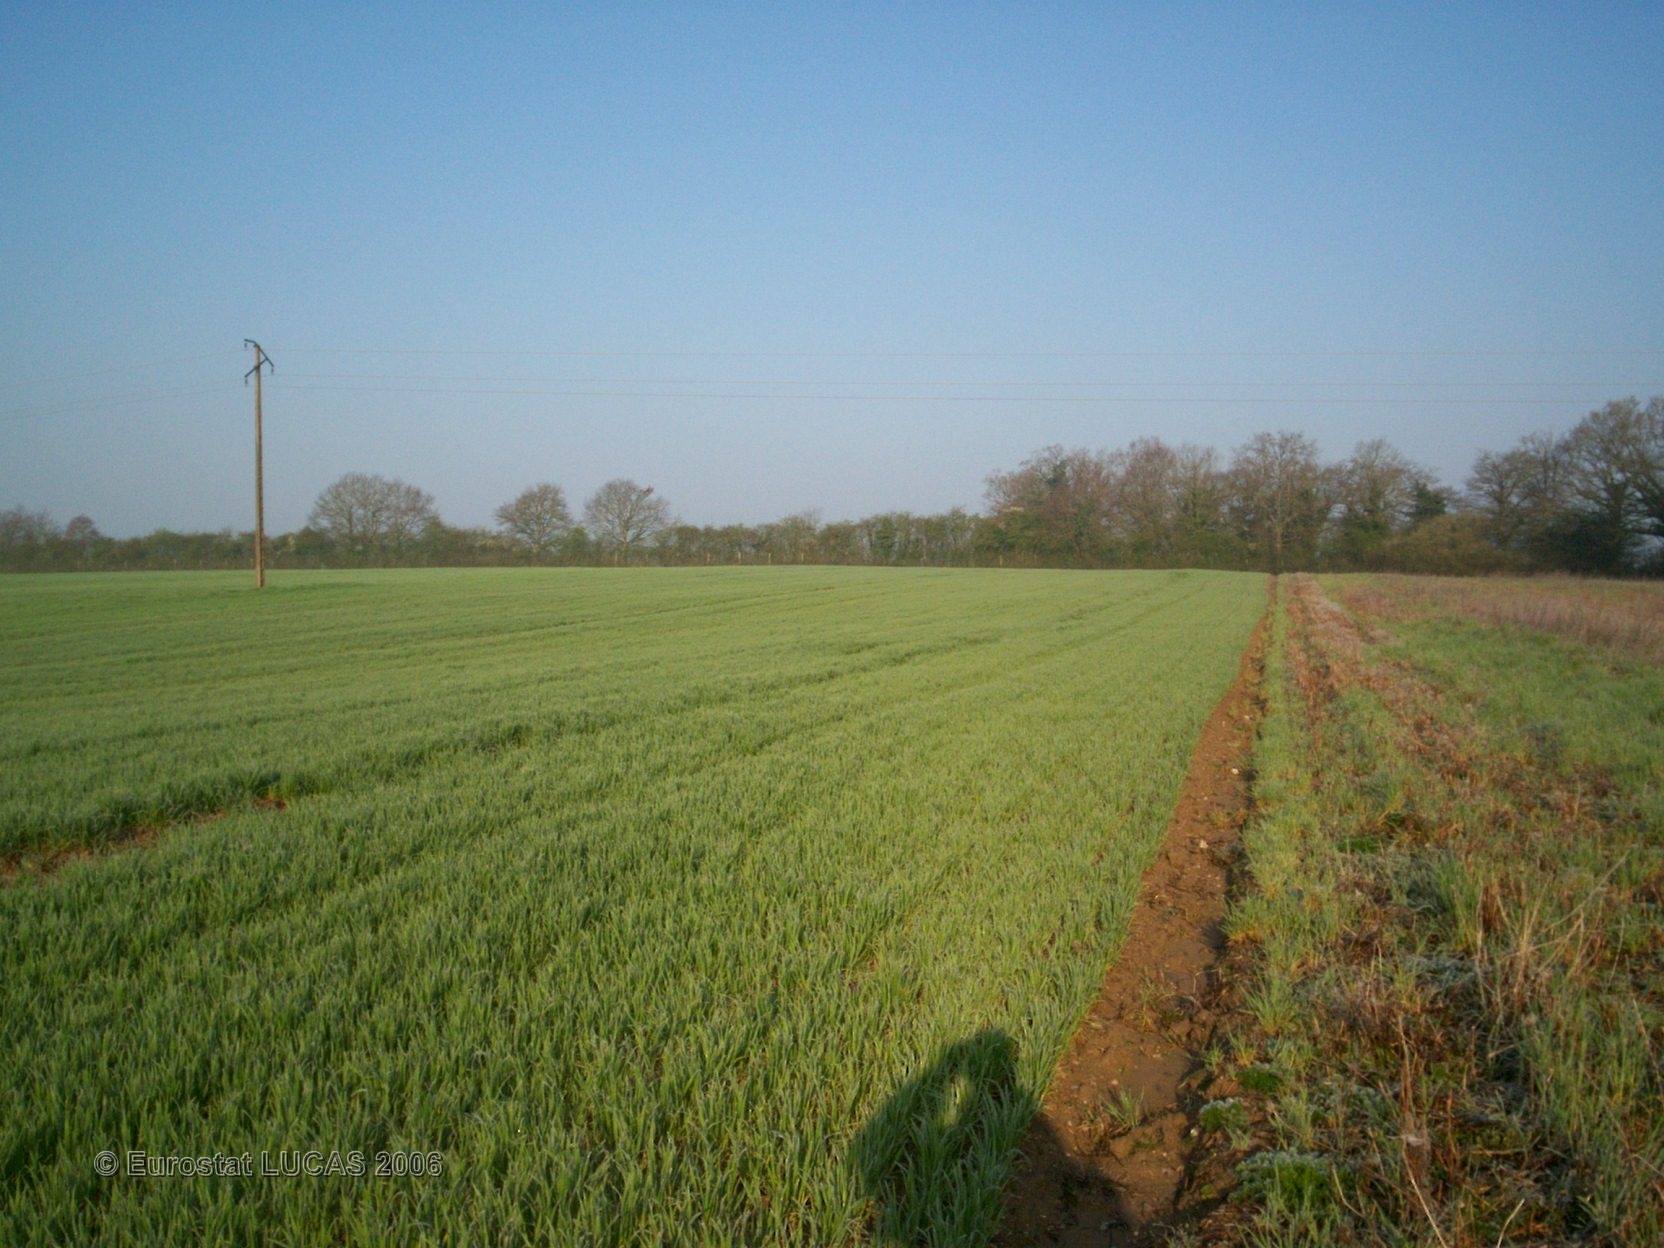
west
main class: Grassland
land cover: Grassland without tree/shrub cover
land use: Agriculture (excluding fallow land and kitchen gardens)
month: April
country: FR
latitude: 46.2315
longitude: 1.0799
